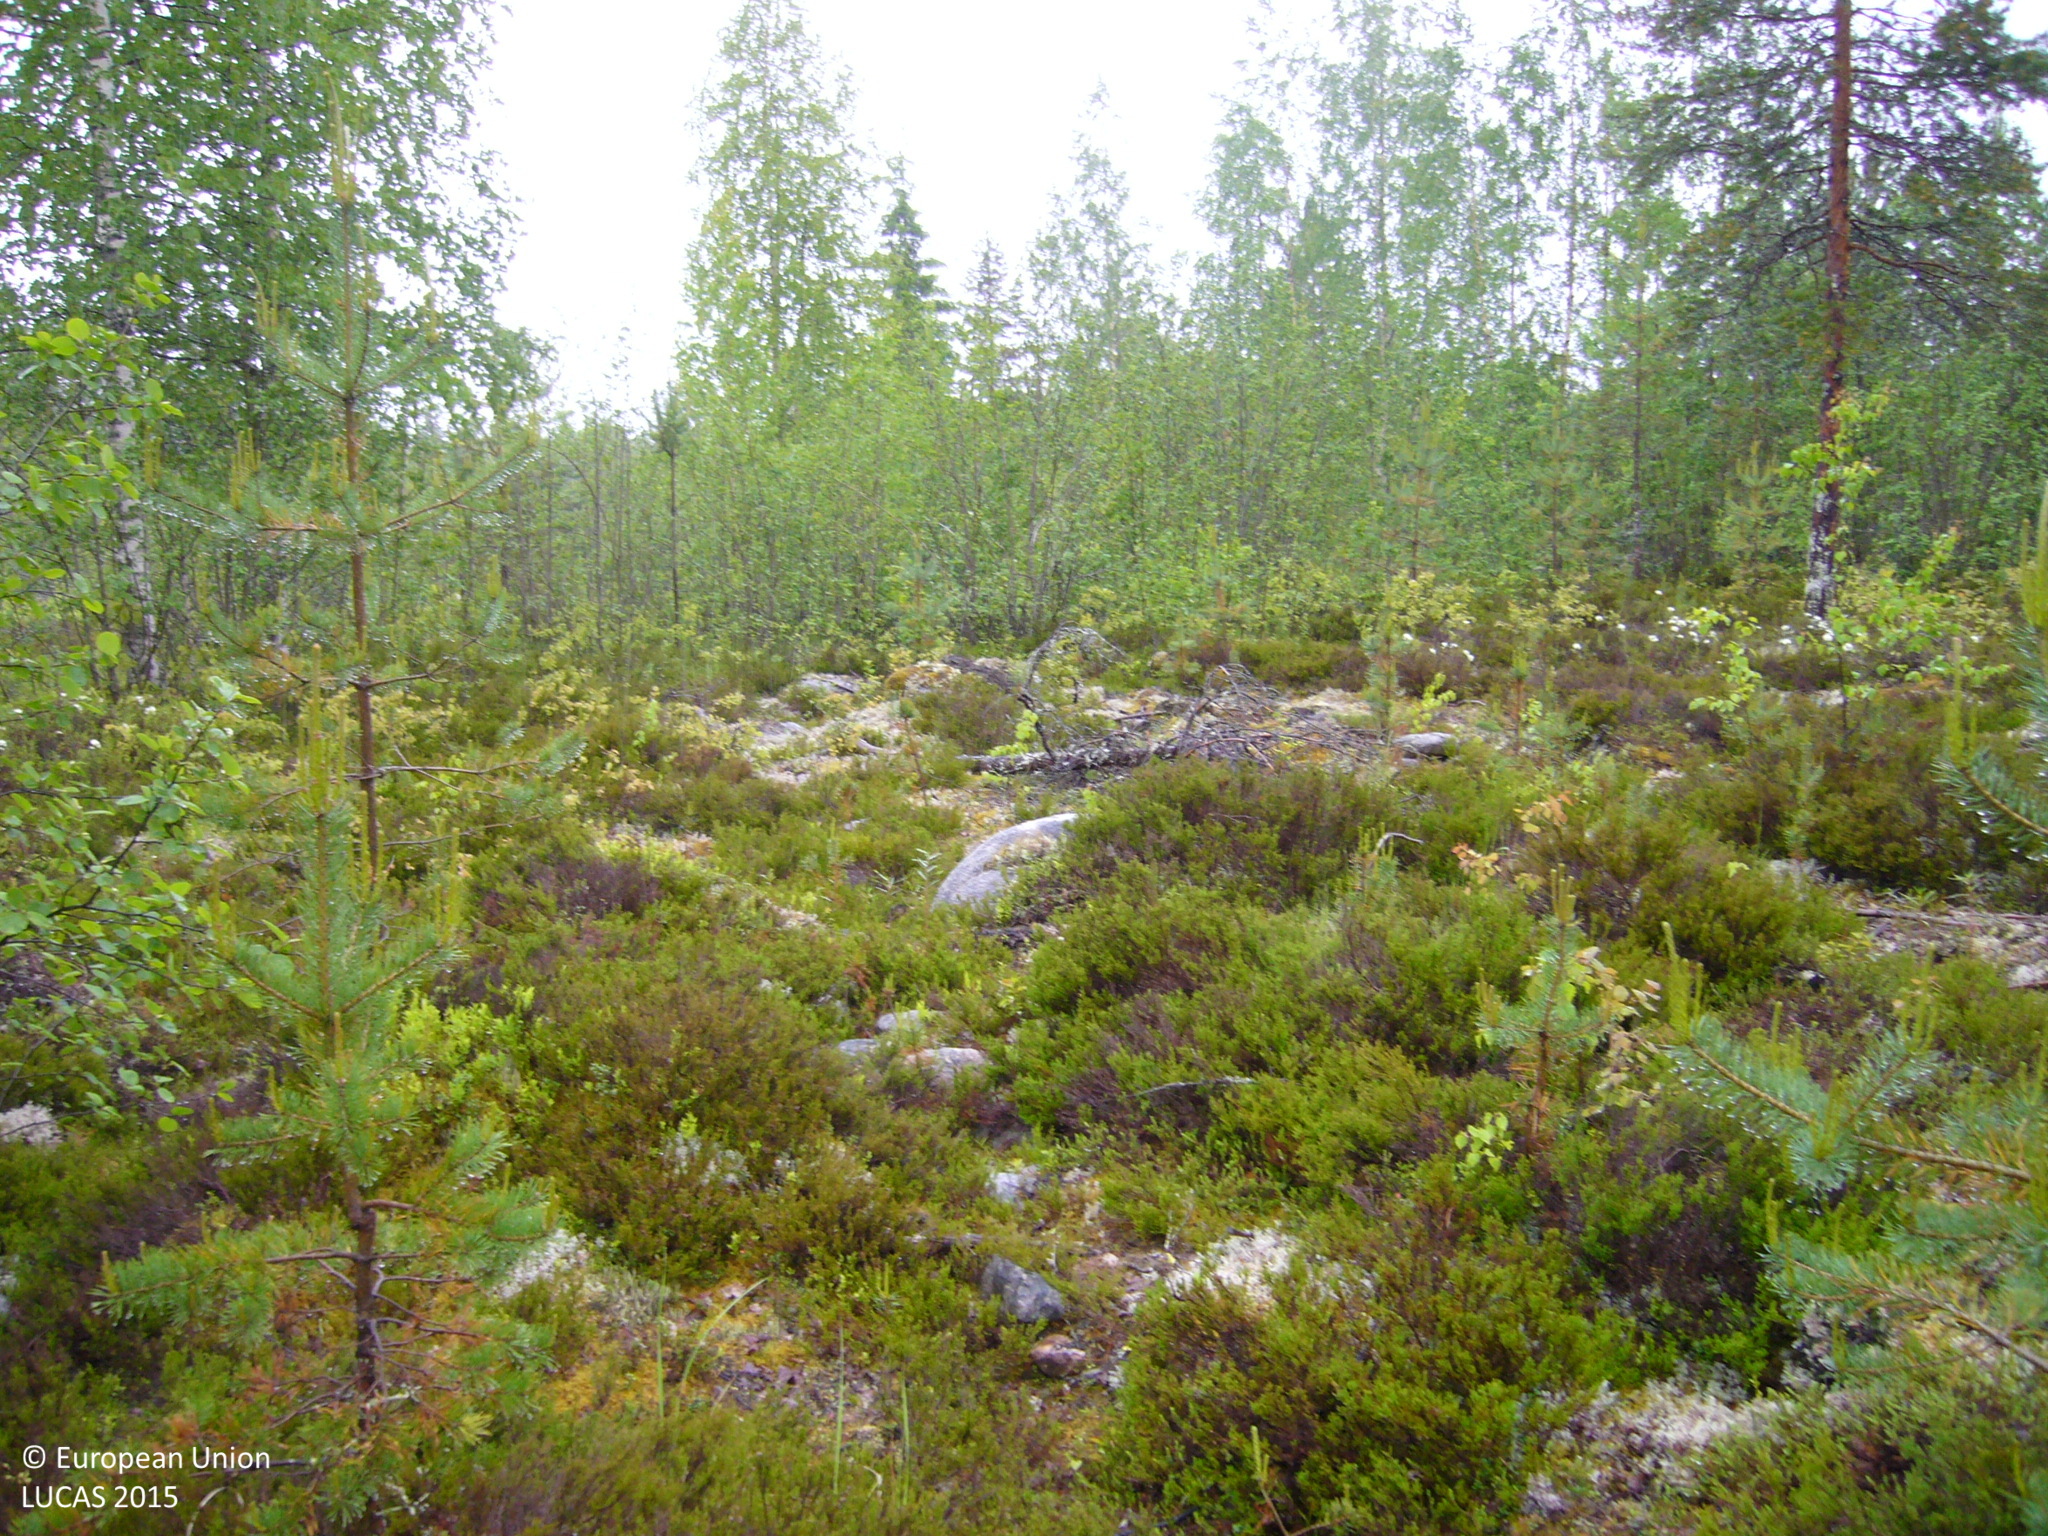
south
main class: Woodland
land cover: Pine dominated mixed woodland
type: boreal forest
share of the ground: 25 - 50 %
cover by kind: shrubs 65 %, coniferous forest trees 25 %, broadleaved forest trees 10 %
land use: Forestry
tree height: > 5 m
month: June
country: FI
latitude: 63.7685
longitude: 25.0331
